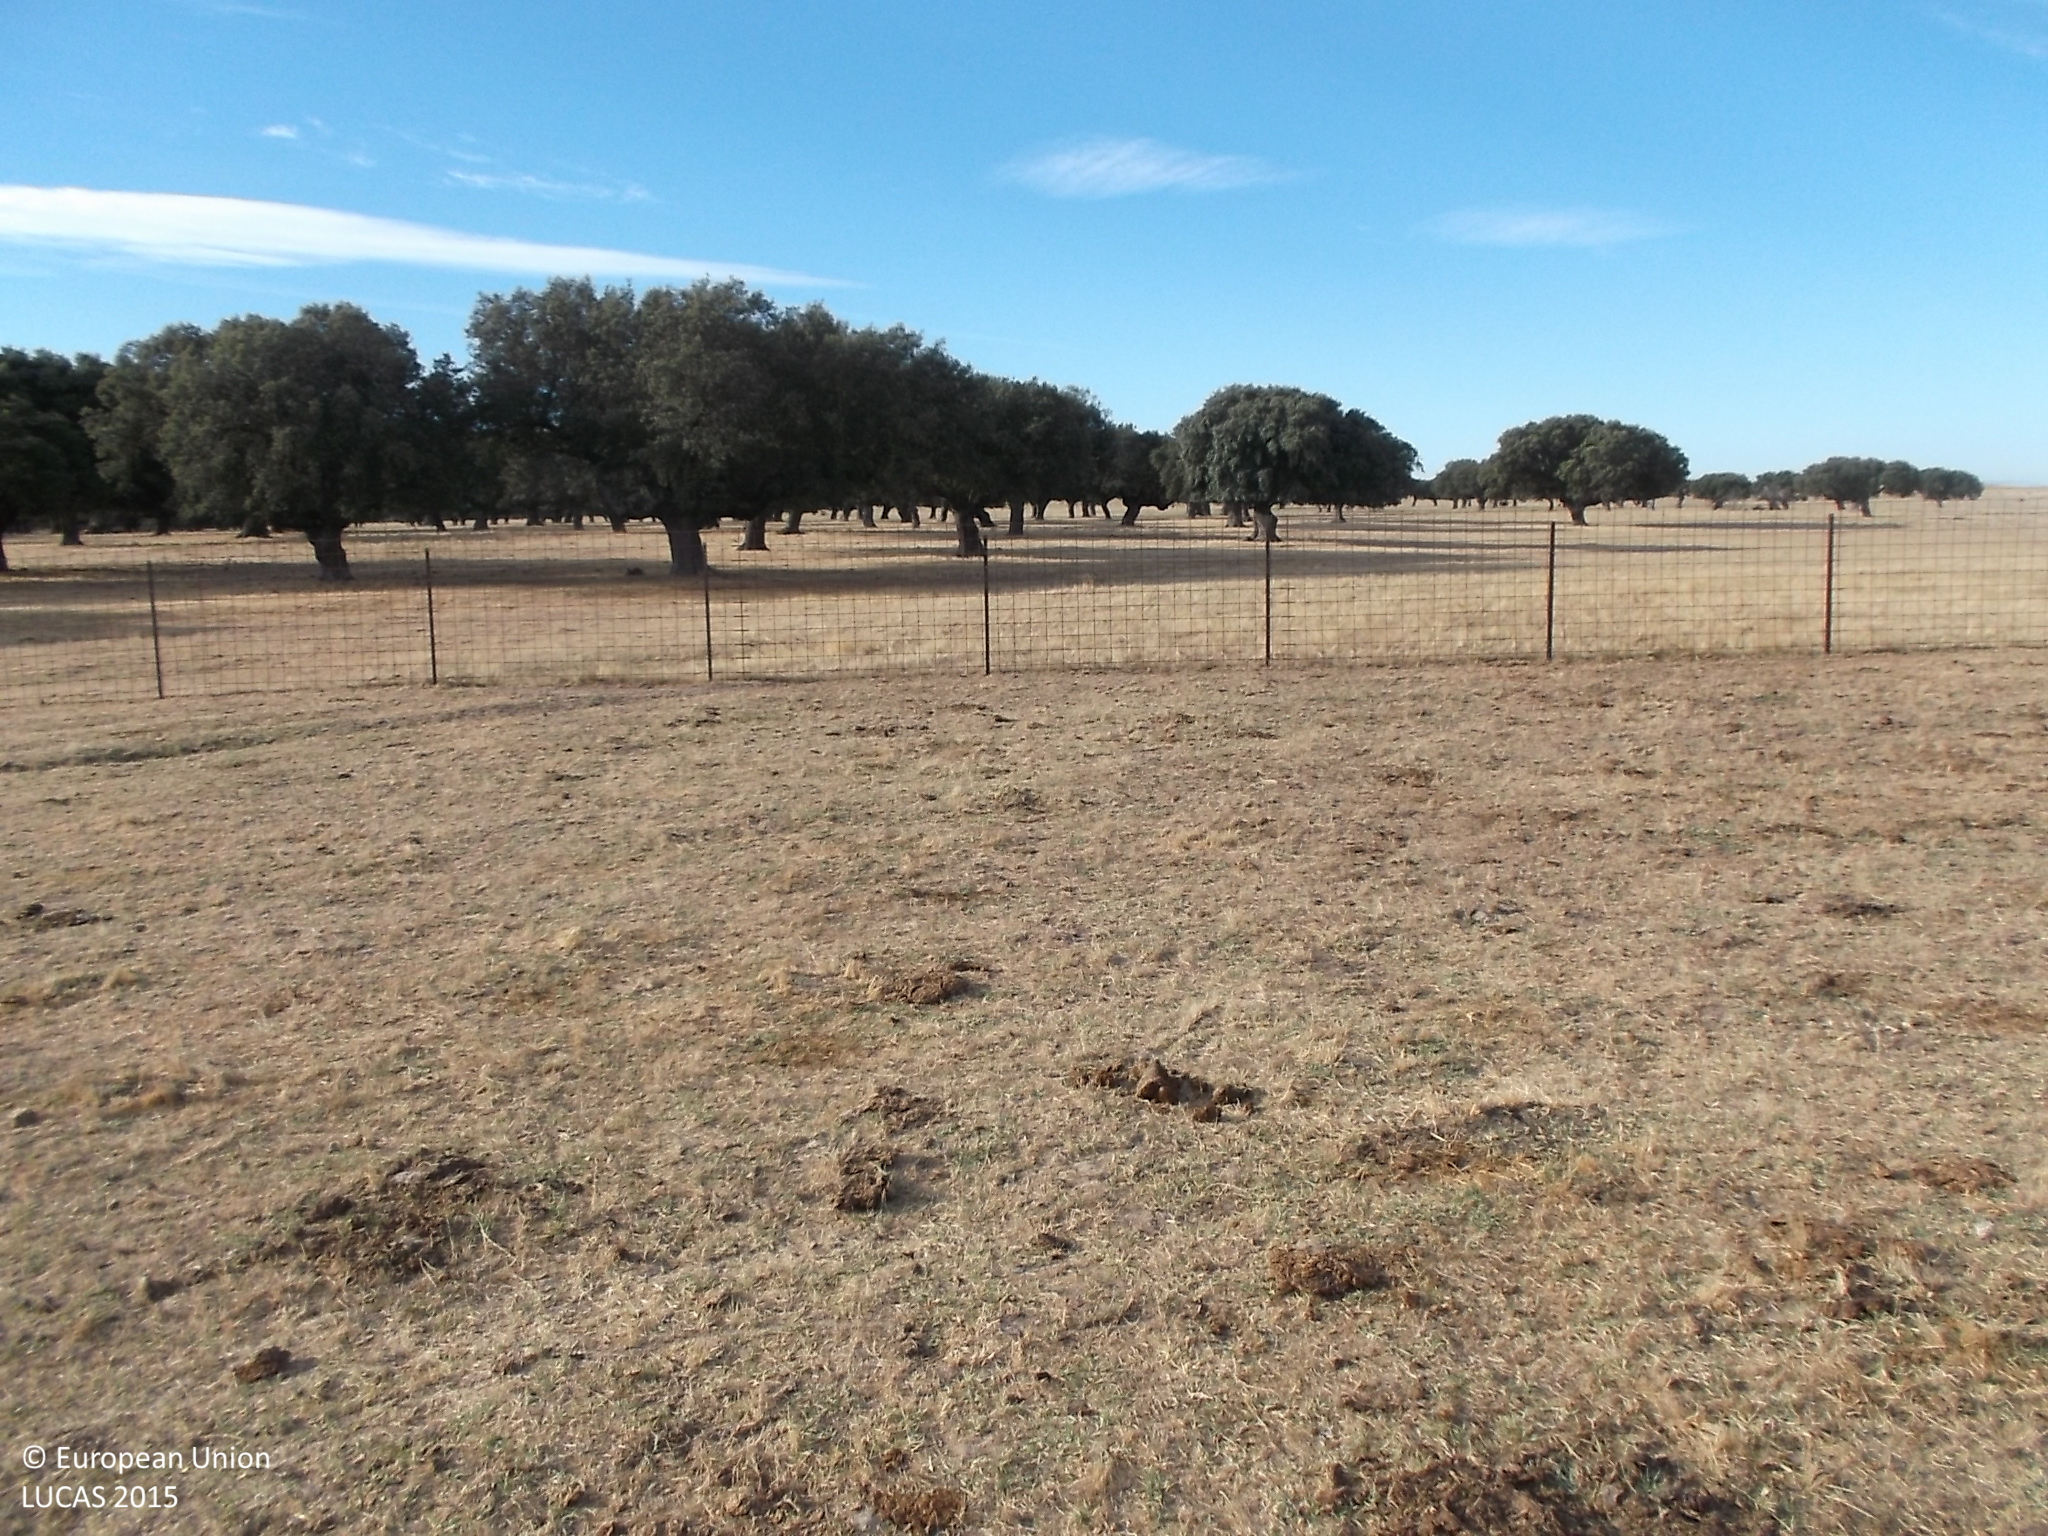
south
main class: Grassland
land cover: Grassland without tree/shrub cover
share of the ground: > 75 %
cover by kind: herbaceous plants 100 %
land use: Agriculture (excluding fallow land and kitchen gardens)
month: July
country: ES
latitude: 40.8309
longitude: -6.2743
